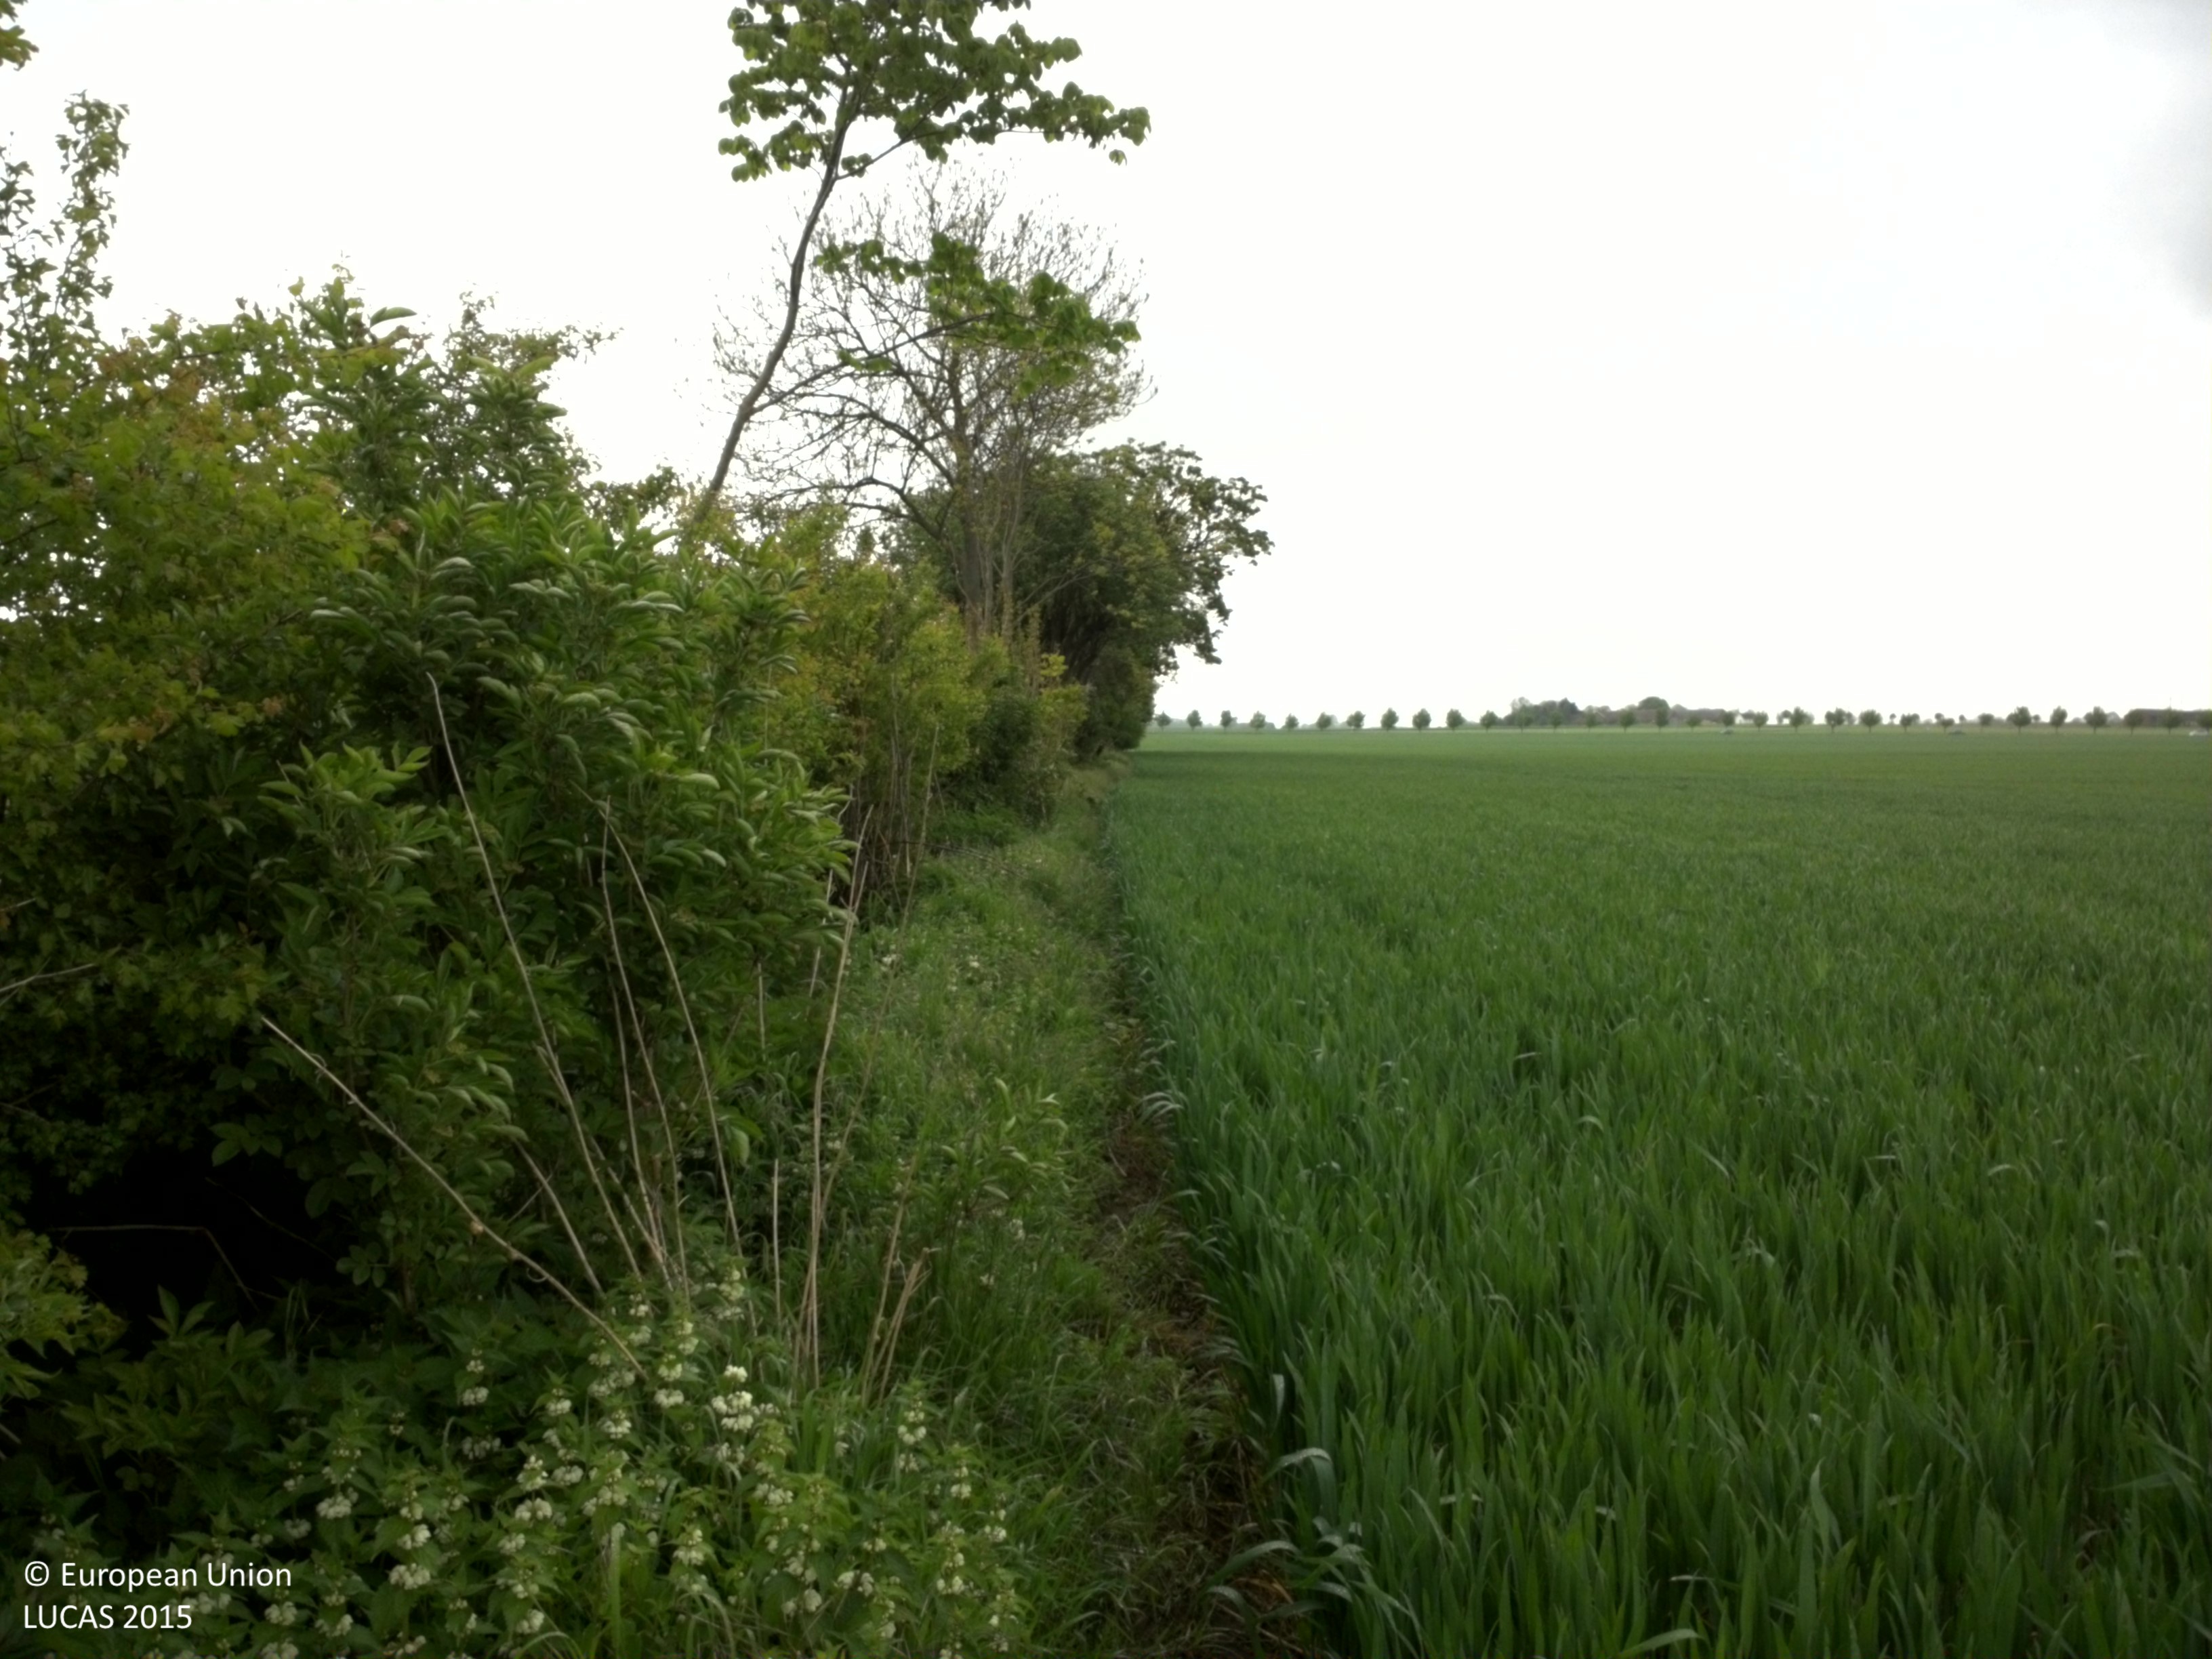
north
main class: Cropland
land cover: Common wheat
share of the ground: > 75 %
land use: Agriculture (excluding fallow land and kitchen gardens)
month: May
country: SE
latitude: 55.7178
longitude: 13.1339
